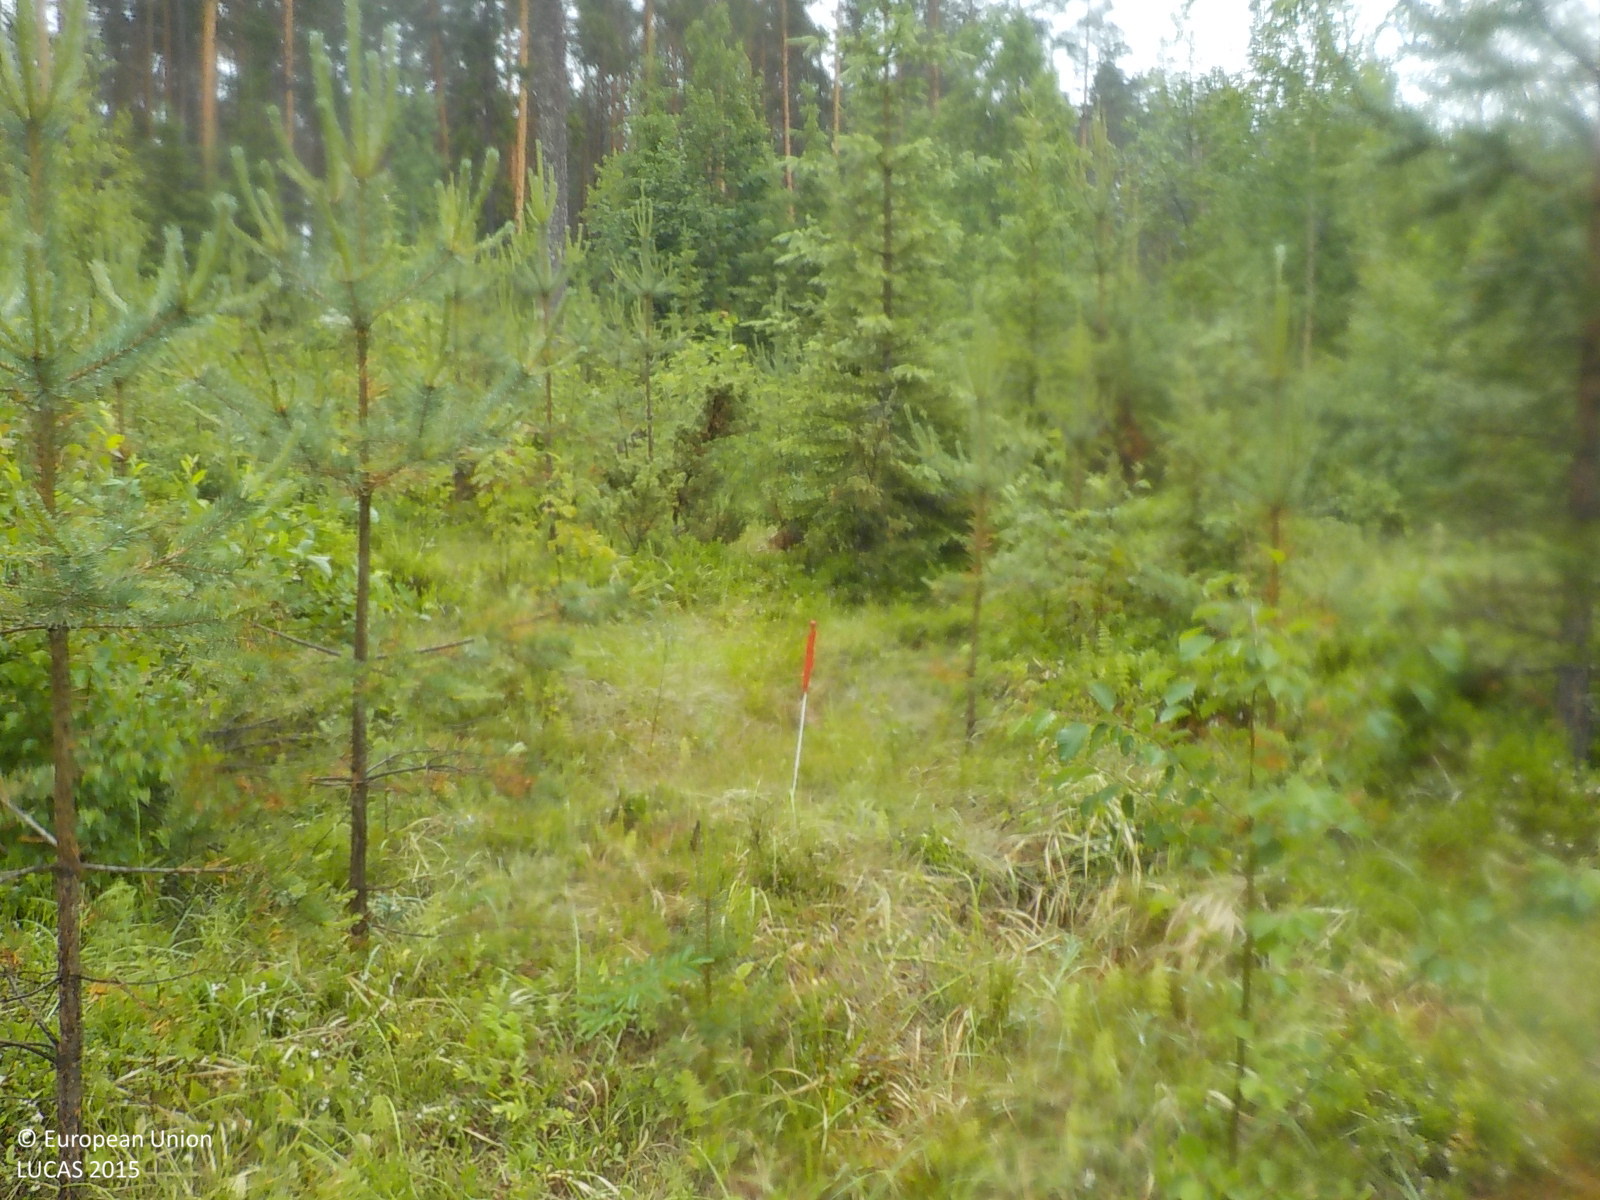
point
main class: Woodland
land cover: Pine dominated mixed woodland
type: boreal forest
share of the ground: > 75 %
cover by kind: coniferous forest trees 50 %, broadleaved forest trees 25 %, shrubs 25 %
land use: Forestry
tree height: < 5 m
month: July
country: SE
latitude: 63.1371
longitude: 17.0179
